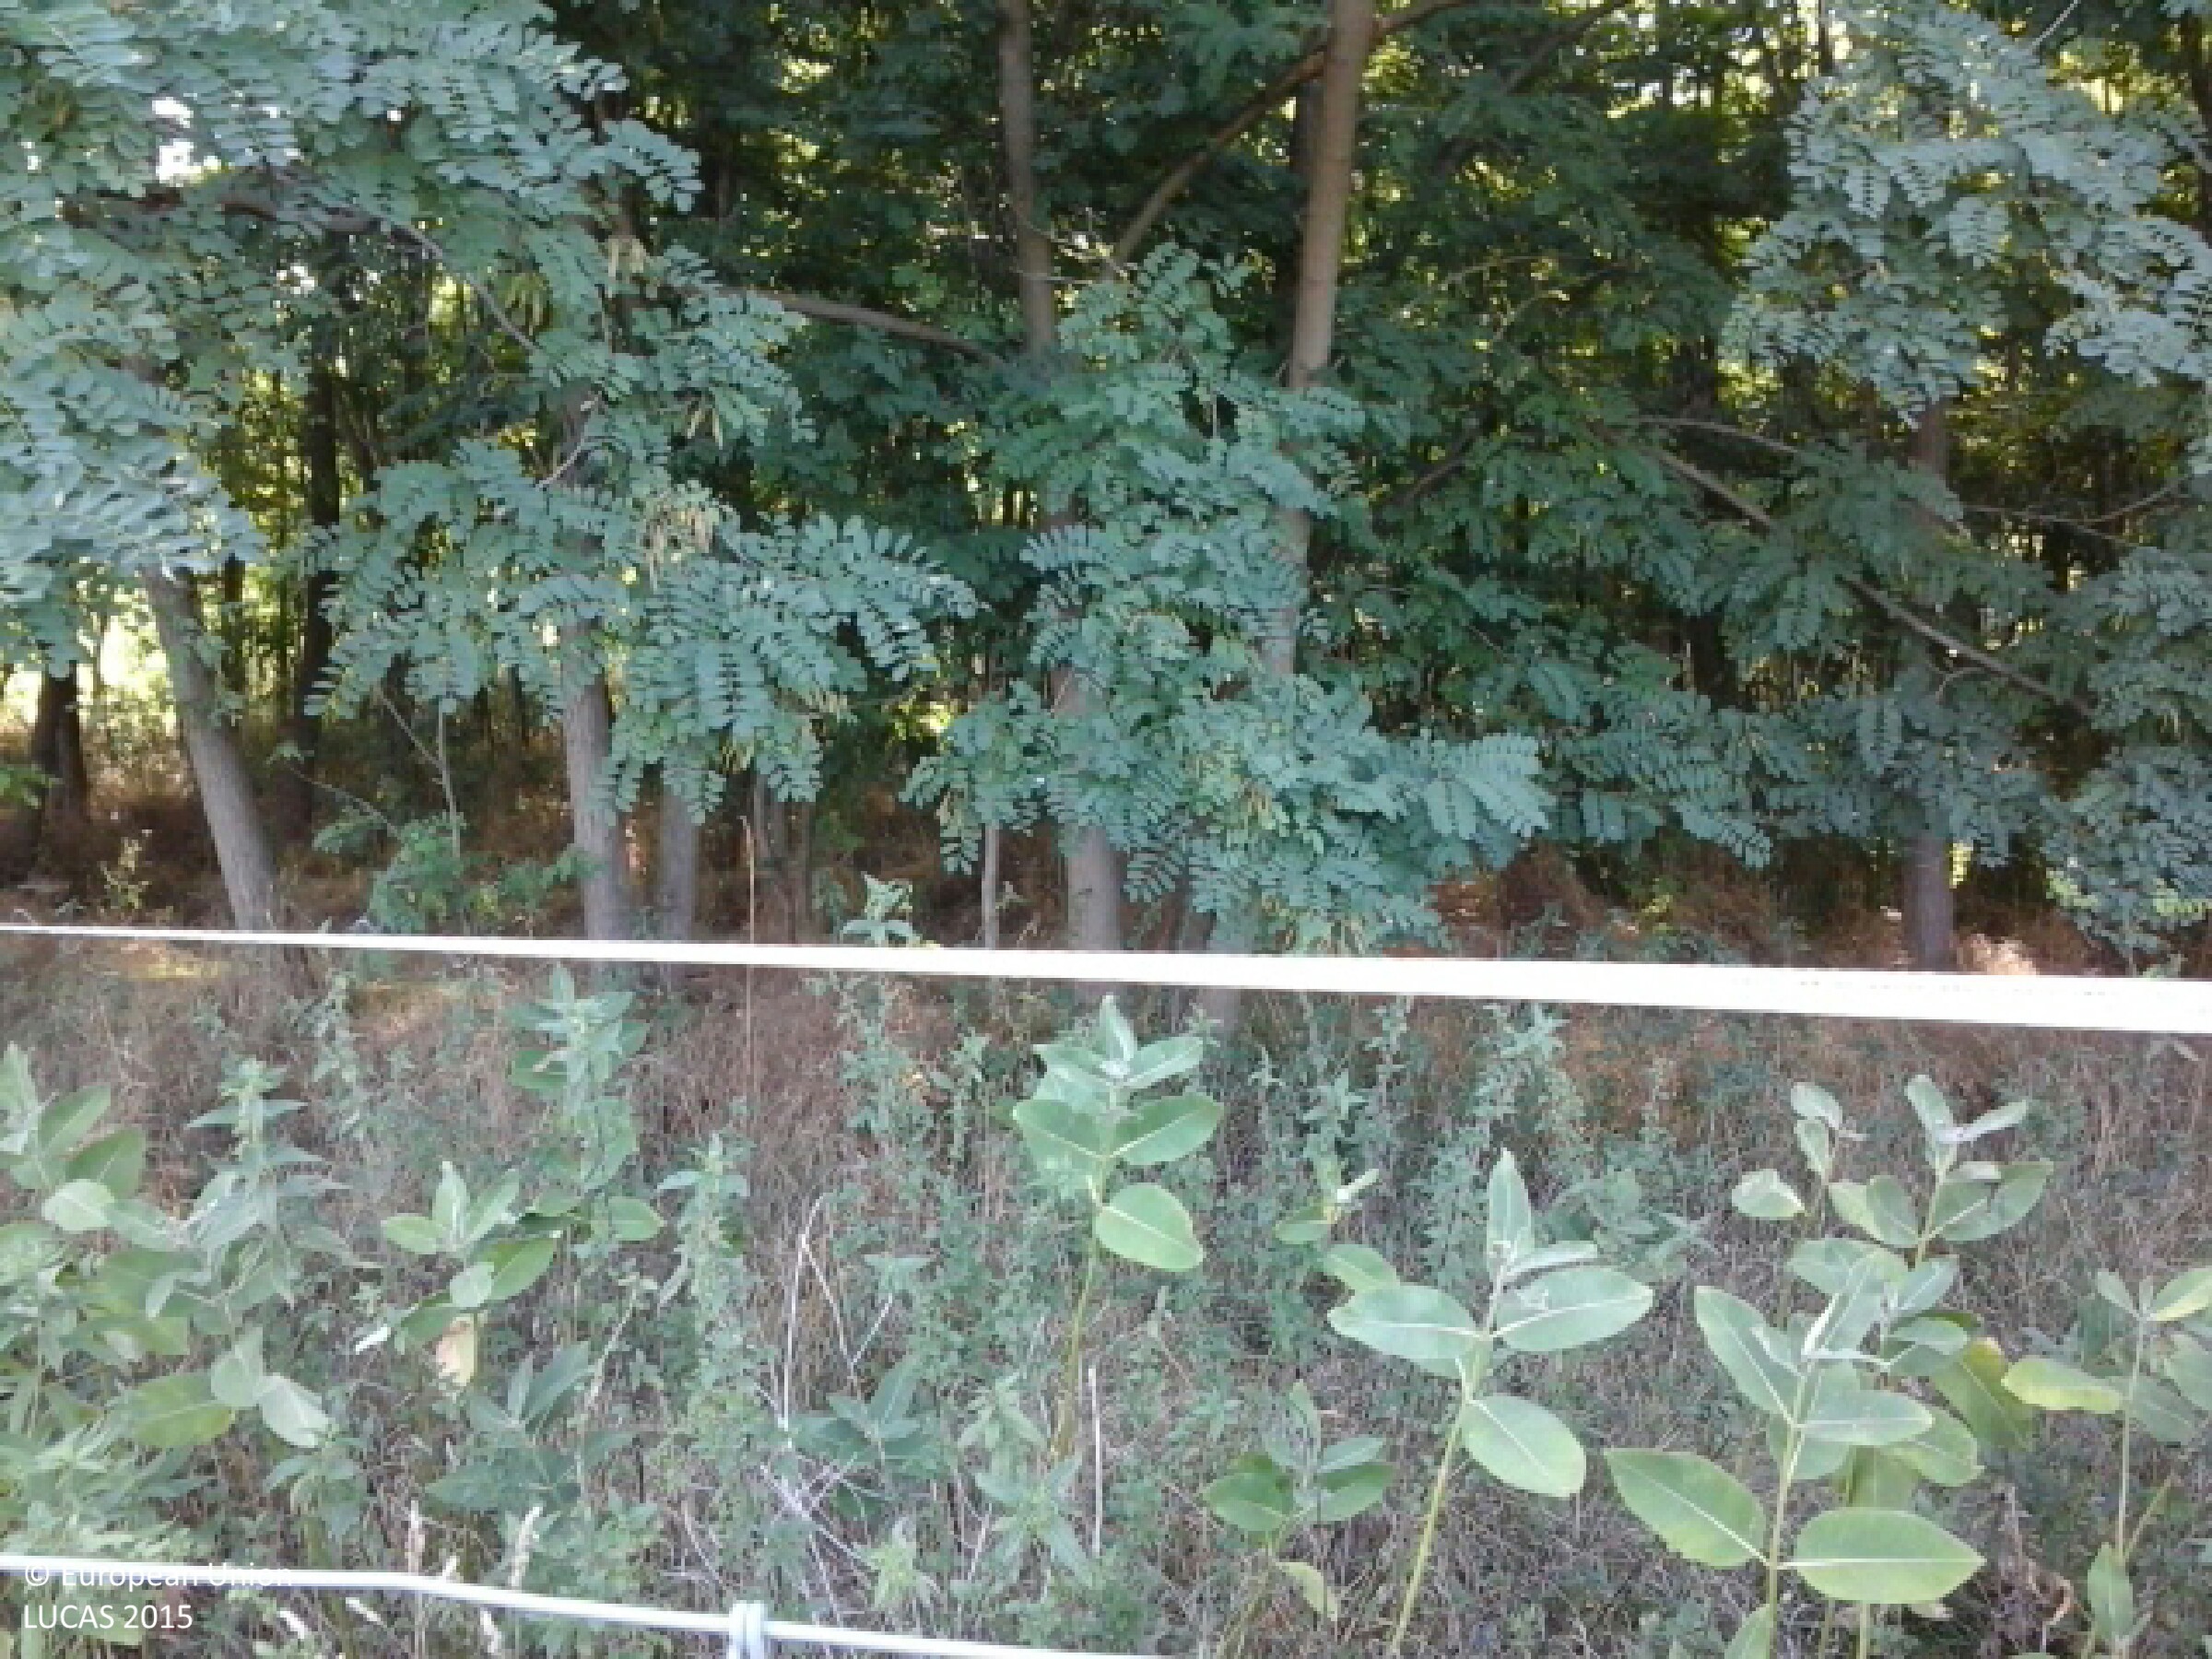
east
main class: Woodland
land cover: Broadleaved woodland
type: exotic forest
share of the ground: > 75 %
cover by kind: broadleaved forest trees 95 %, herbaceous plants 5 %
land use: Forestry
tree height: > 5 m
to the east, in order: Broadleaved woodland
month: August
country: HU
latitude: 47.5588
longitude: 17.9180
